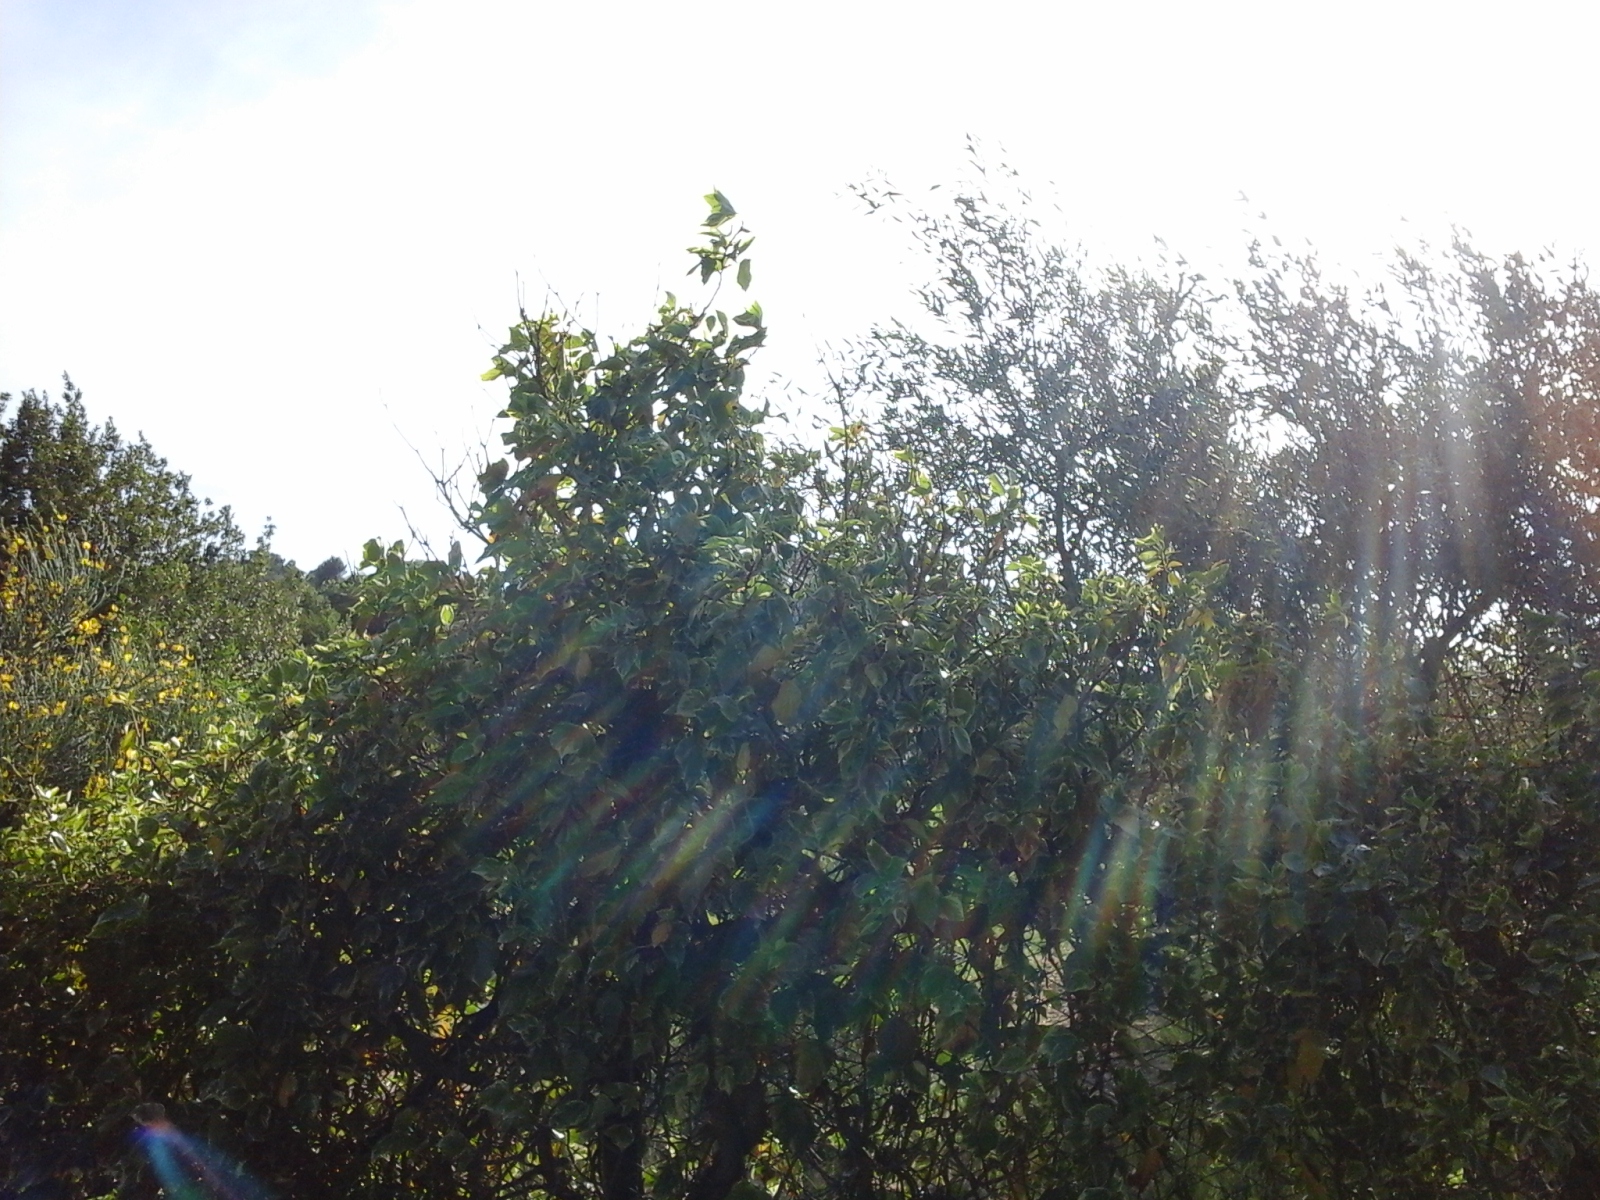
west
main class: Woodland
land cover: Broadleaved woodland
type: broadleaved evergreen forest
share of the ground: > 75 %
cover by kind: broadleaved forest trees 70 %, shrubs 20 %, coniferous forest trees 10 %
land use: Forestry
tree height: > 5 m
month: May
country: IT
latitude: 37.4985
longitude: 14.0306
